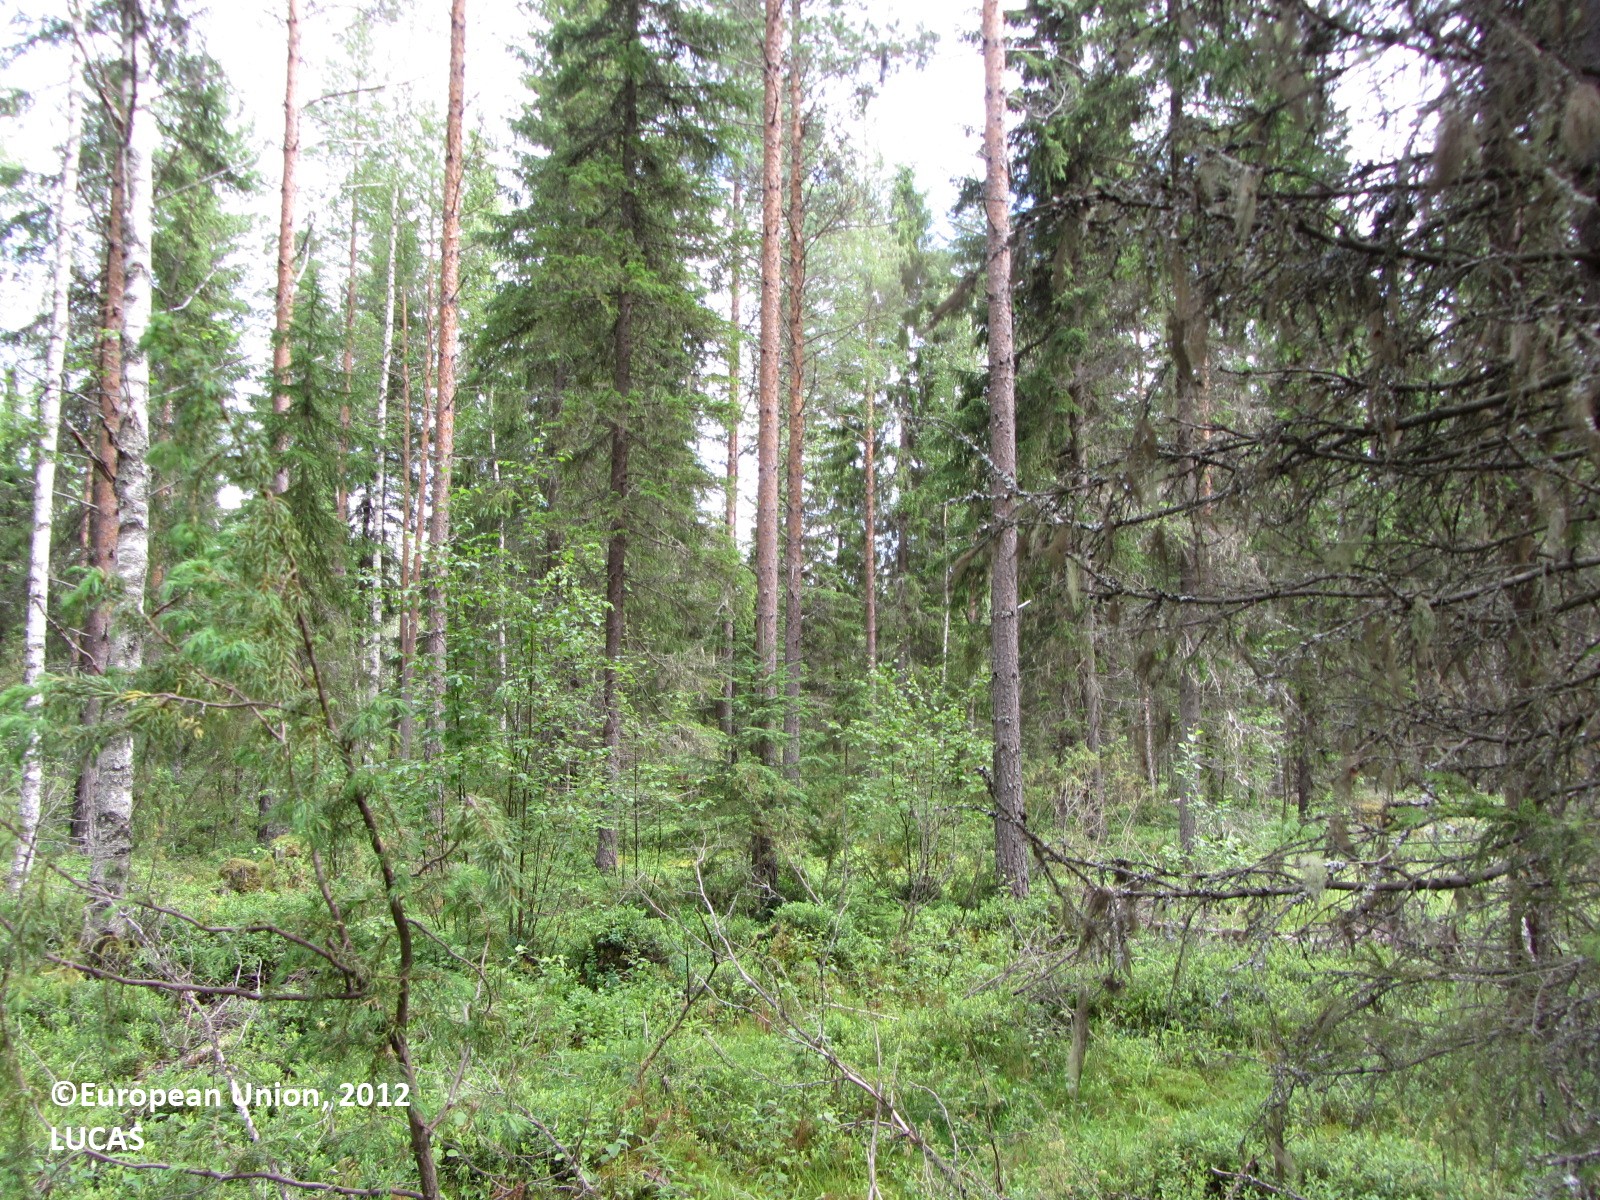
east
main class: Woodland
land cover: Other coniferous woodland
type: boreal forest
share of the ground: > 75 %
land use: Forestry
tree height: > 5 m
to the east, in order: Other coniferous woodland; Tracks; Other coniferous woodland; Tracks; Other coniferous woodland; Grassland with sparse tree/shrub cover; Other coniferous woodland; Ponds and wetlands; Pine dominated mixed woodland; Shrubland with sparse tree cover; Other coniferous woodland; Tracks; Other coniferous woodland; Paved roads, cycling and walking lanes; Shrubland with sparse tree cover; Ditches and canals; Other coniferous woodland
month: July
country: FI
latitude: 63.6945
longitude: 25.4078
